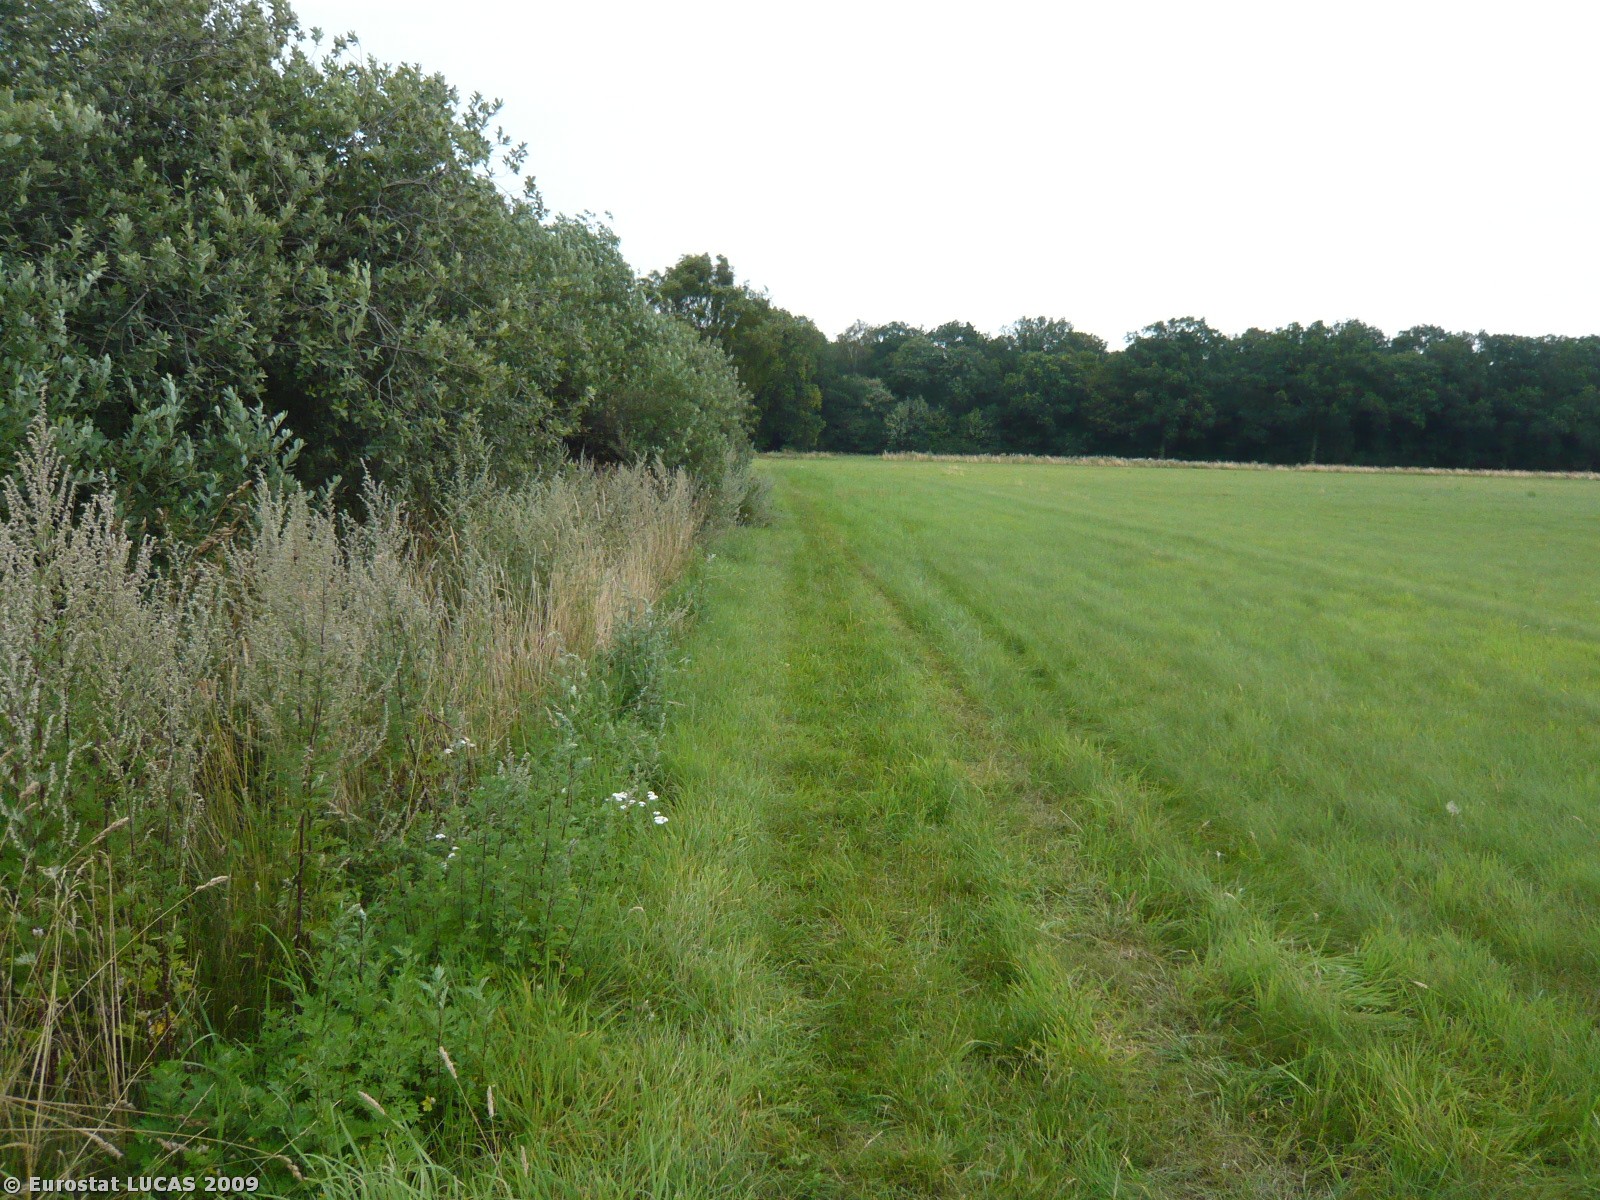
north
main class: Grassland
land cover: Grassland without tree/shrub cover
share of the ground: > 75 %
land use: Agriculture (excluding fallow land and kitchen gardens)
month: August
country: DK
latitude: 55.9923
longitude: 12.0020
